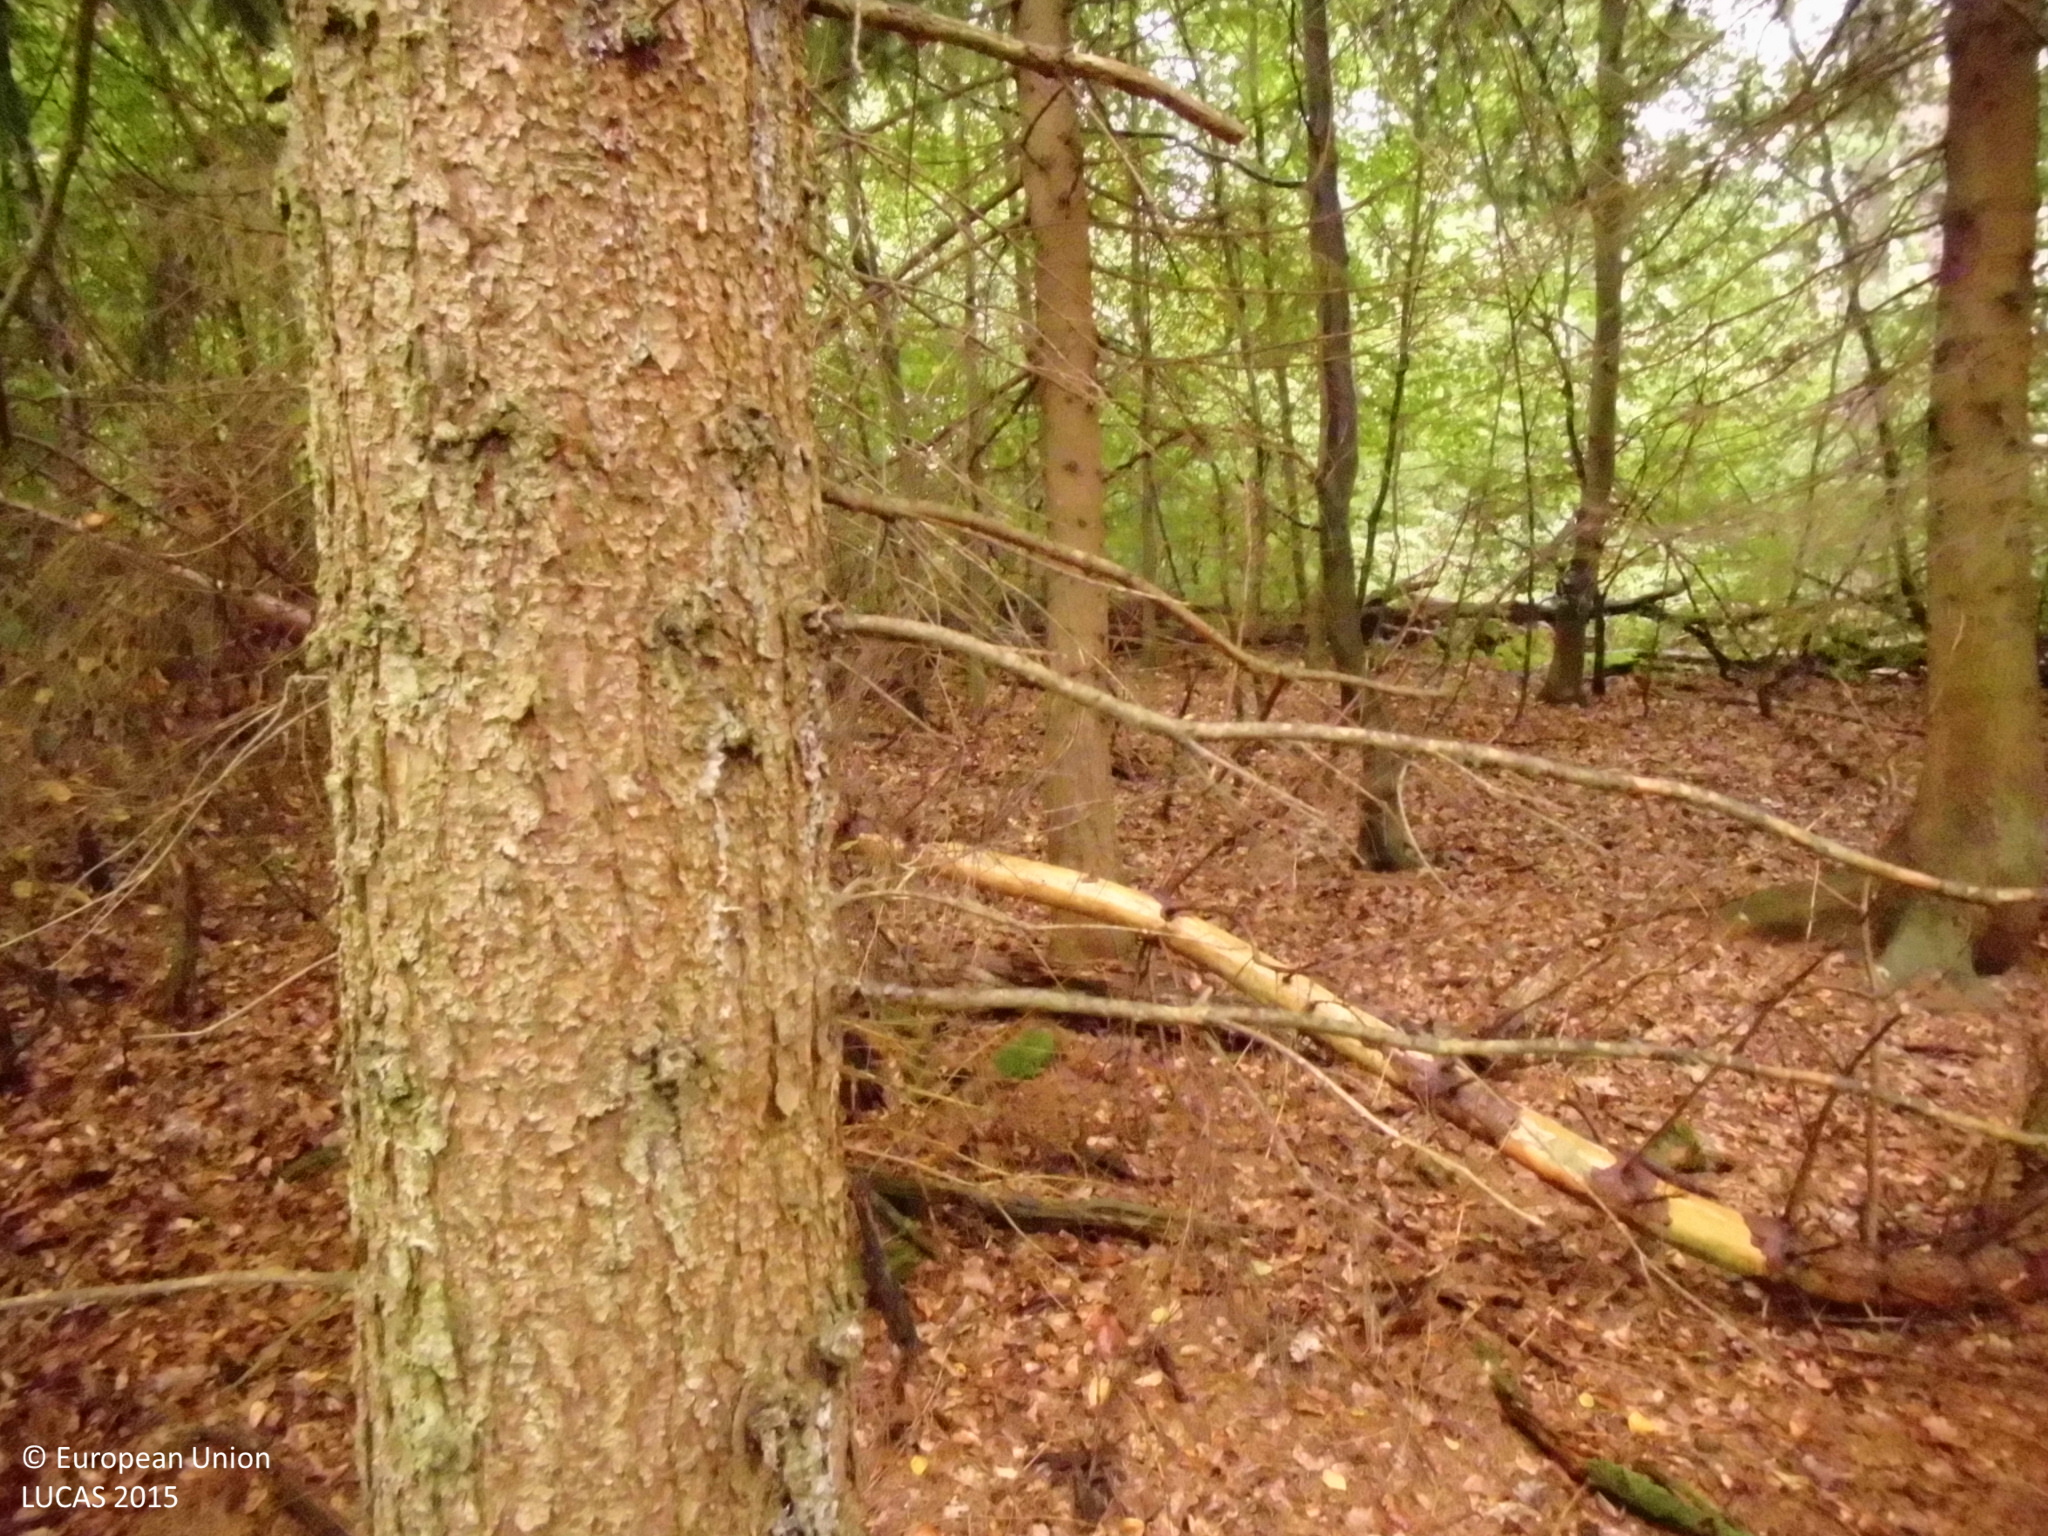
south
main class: Woodland
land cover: Broadleaved woodland
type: mesophytic deciduous forest
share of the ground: > 75 %
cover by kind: broadleaved forest trees 100 %
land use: Forestry
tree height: > 5 m
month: September
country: DE
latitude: 50.6239
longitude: 7.4700
